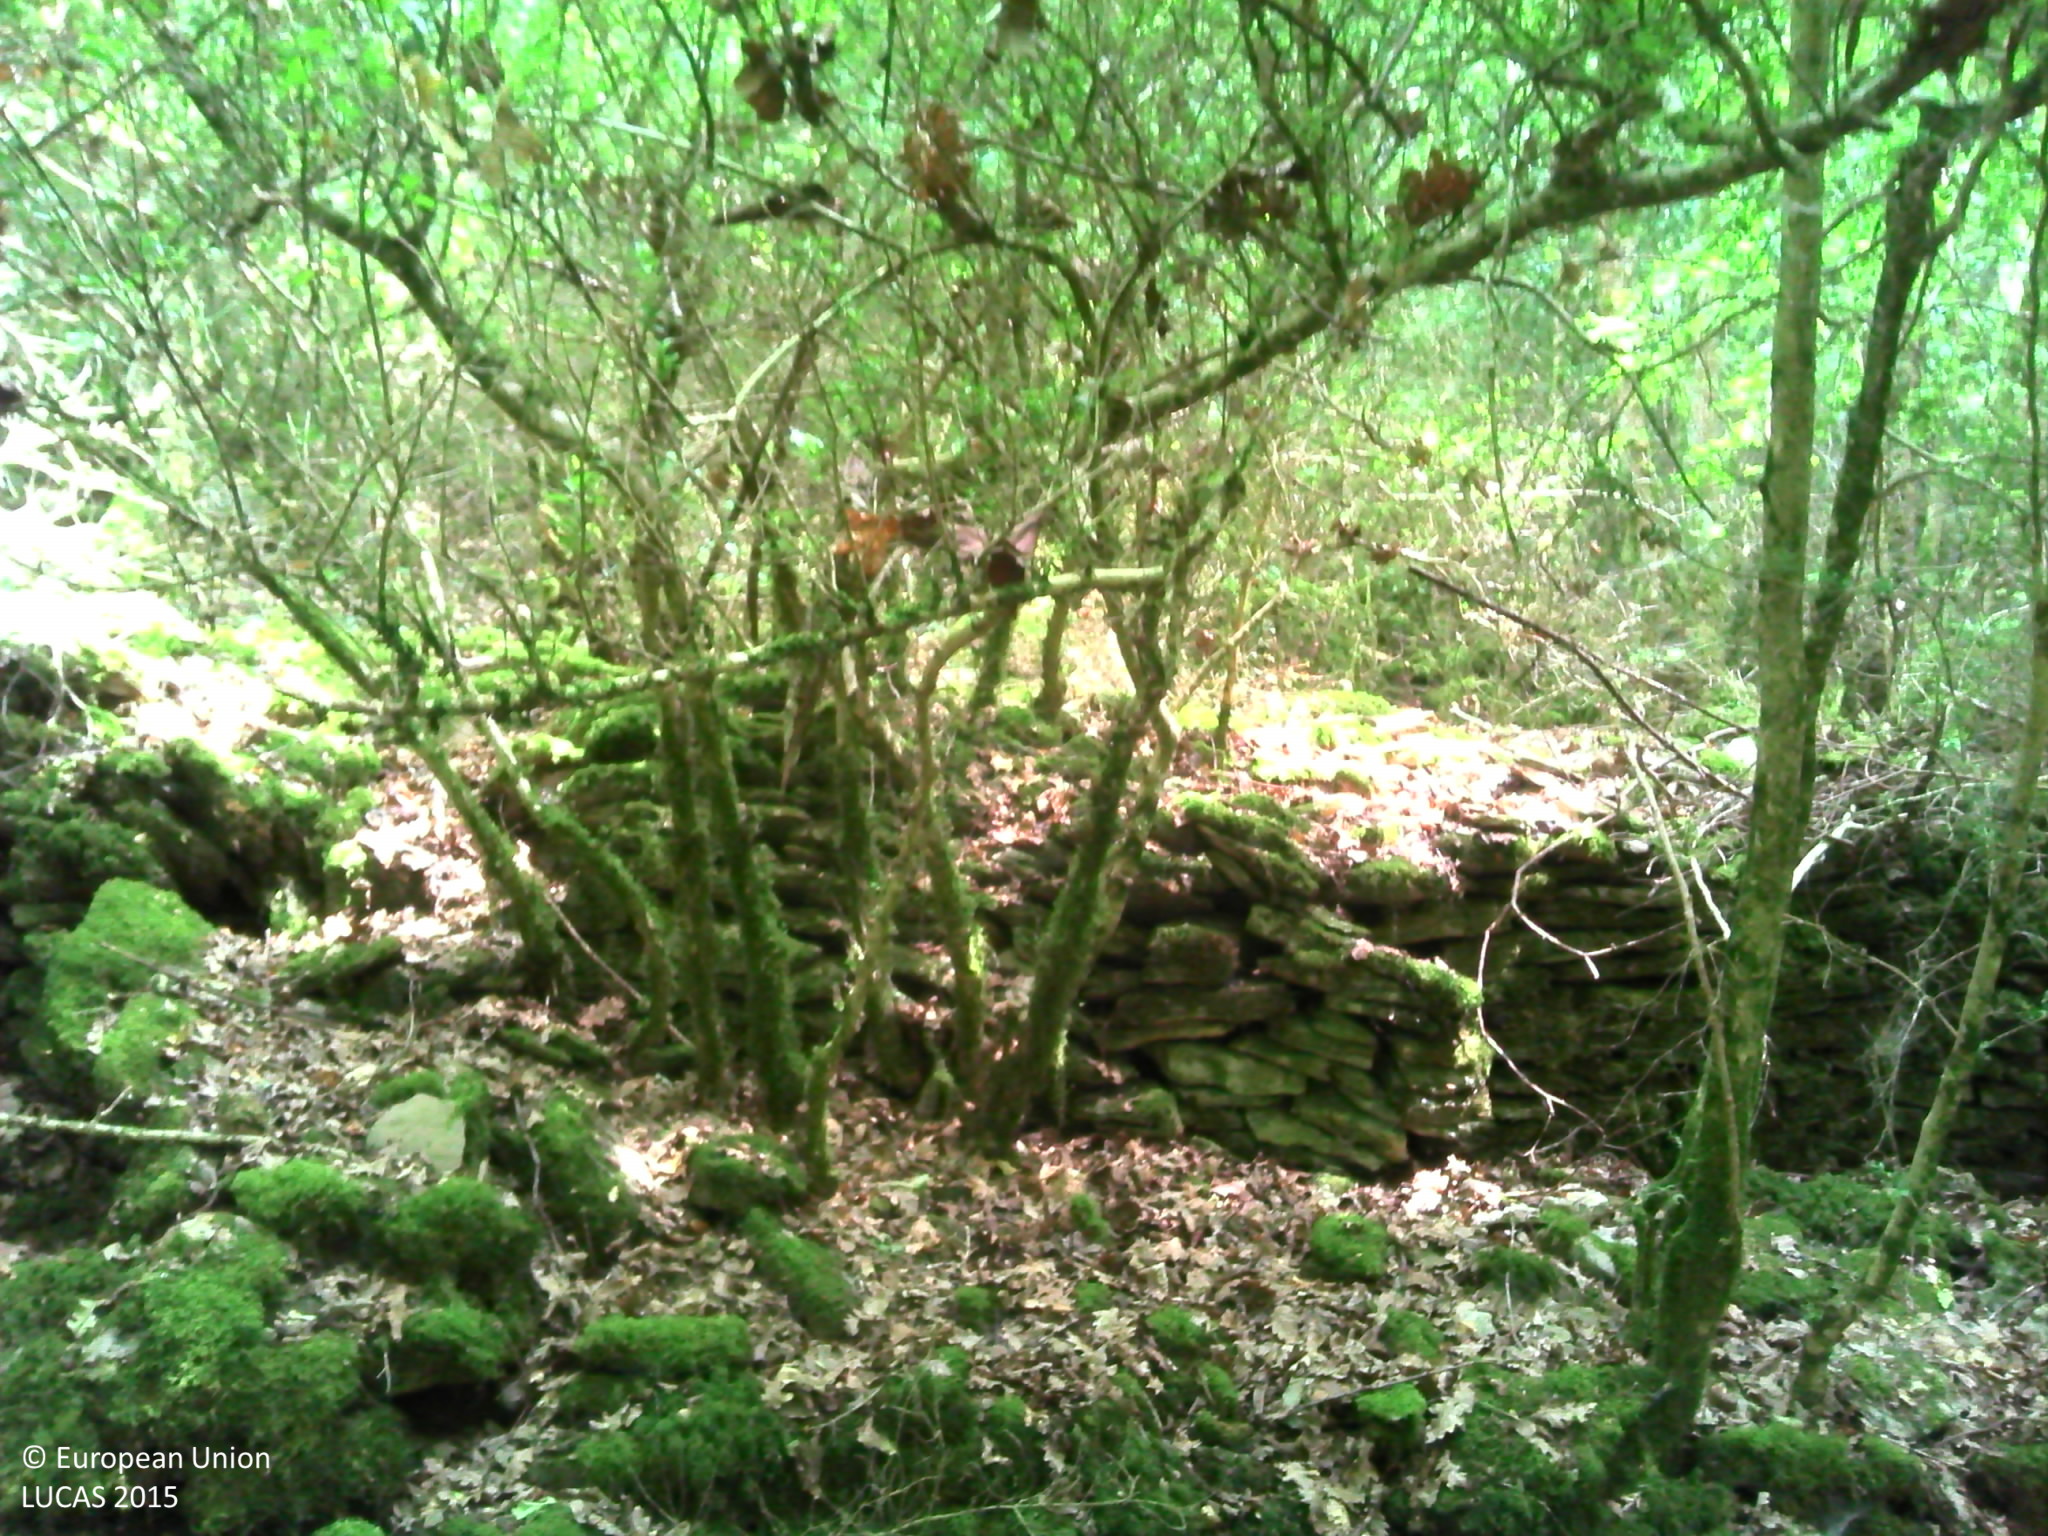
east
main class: Woodland
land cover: Broadleaved woodland
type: mesophytic deciduous forest
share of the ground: > 75 %
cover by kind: broadleaved forest trees 60 %, herbaceous plants 35 %, lichens and mosses 5 %
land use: Forestry
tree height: > 5 m
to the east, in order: Broadleaved woodland; Dry stone walls; Broadleaved woodland; Other mixed woodland; Tracks; Other mixed woodland
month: June
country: FR
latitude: 46.5687
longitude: 4.8222
